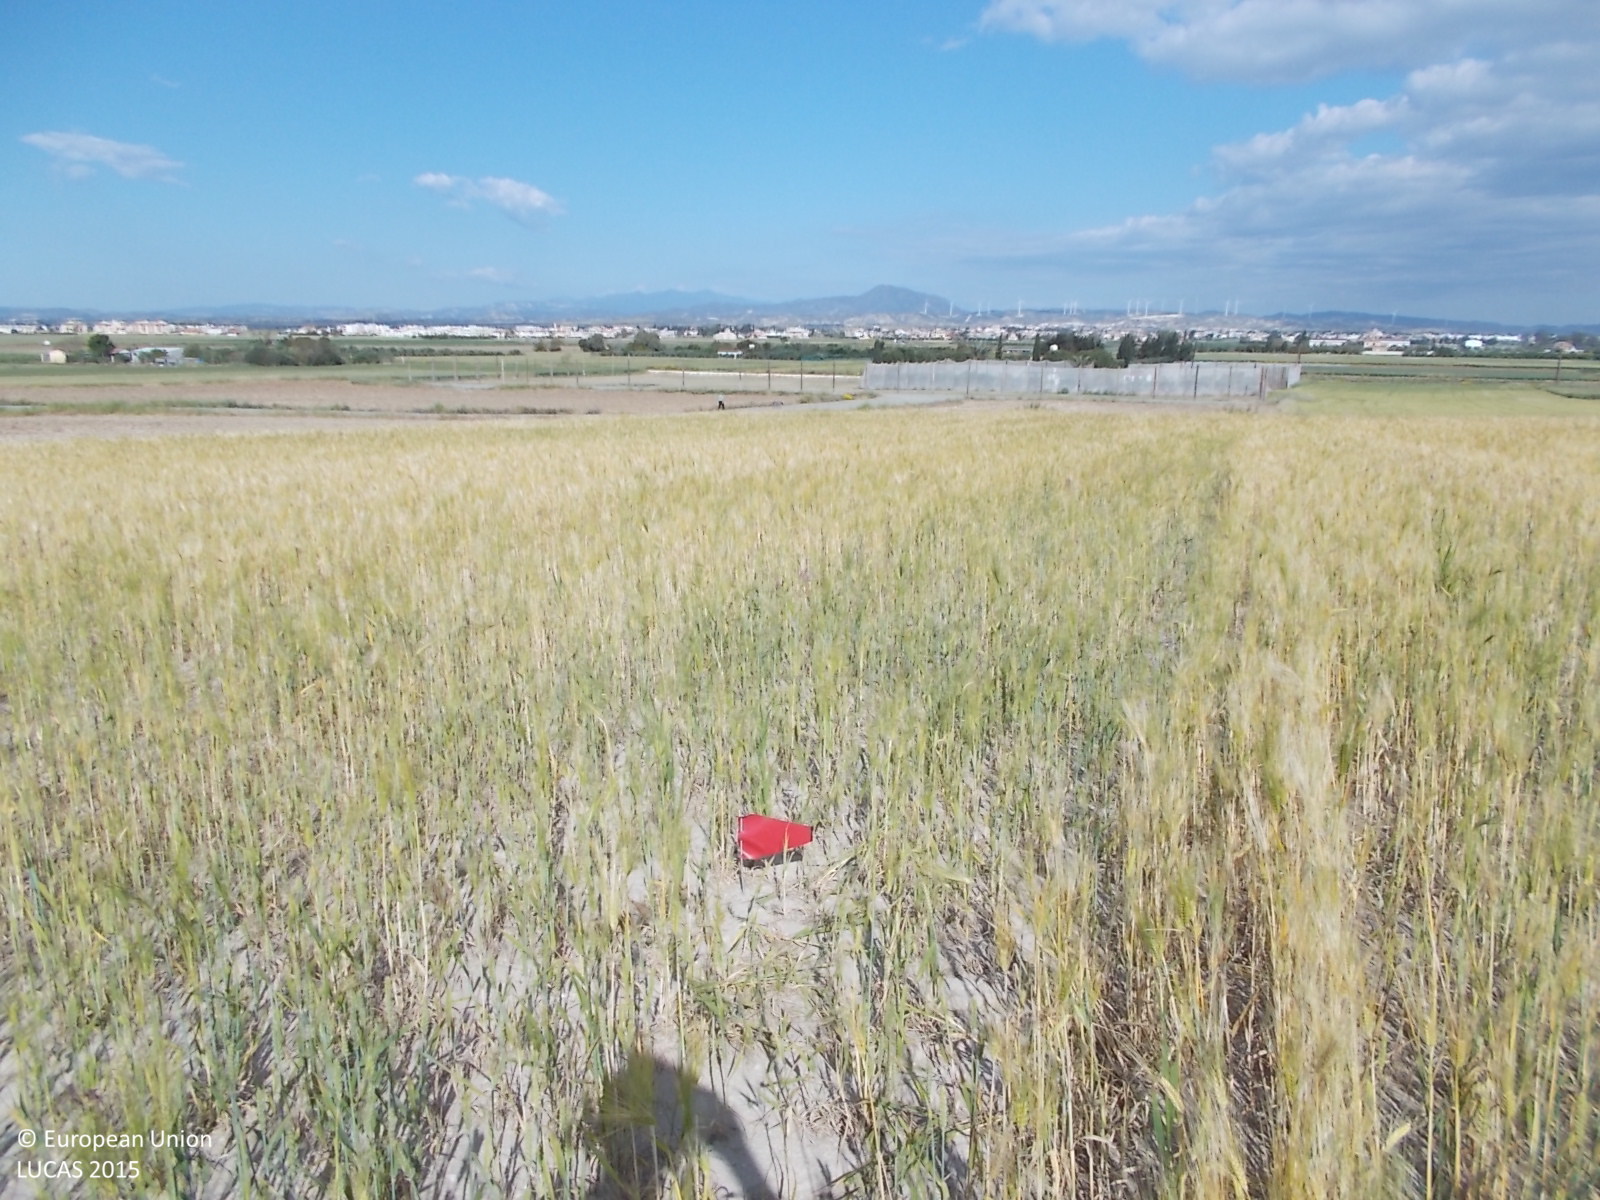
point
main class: Cropland
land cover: Barley
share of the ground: > 75 %
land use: Agriculture (excluding fallow land and kitchen gardens)
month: April
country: CY
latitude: 34.8259
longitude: 33.6010
